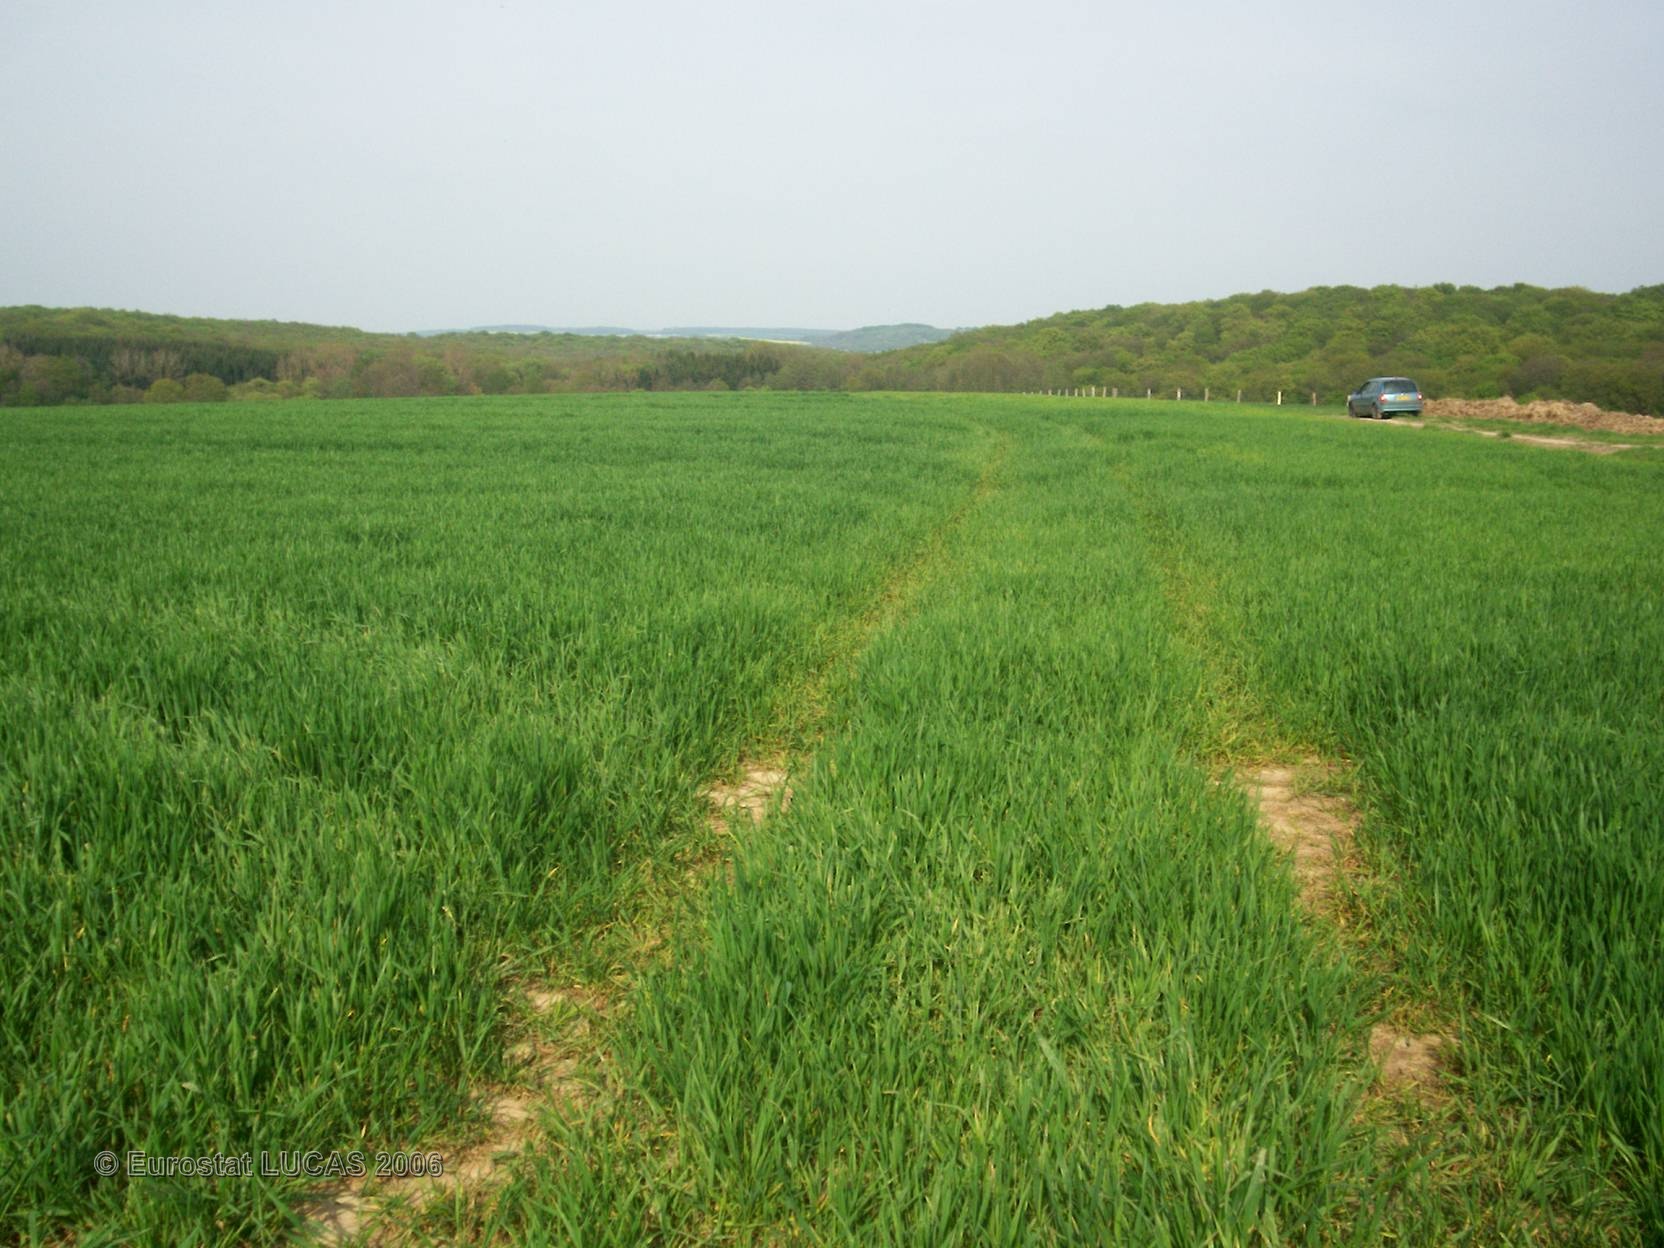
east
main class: Cropland
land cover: Common wheat
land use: Agriculture (excluding fallow land and kitchen gardens)
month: May
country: FR
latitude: 49.2467
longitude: 6.4420
